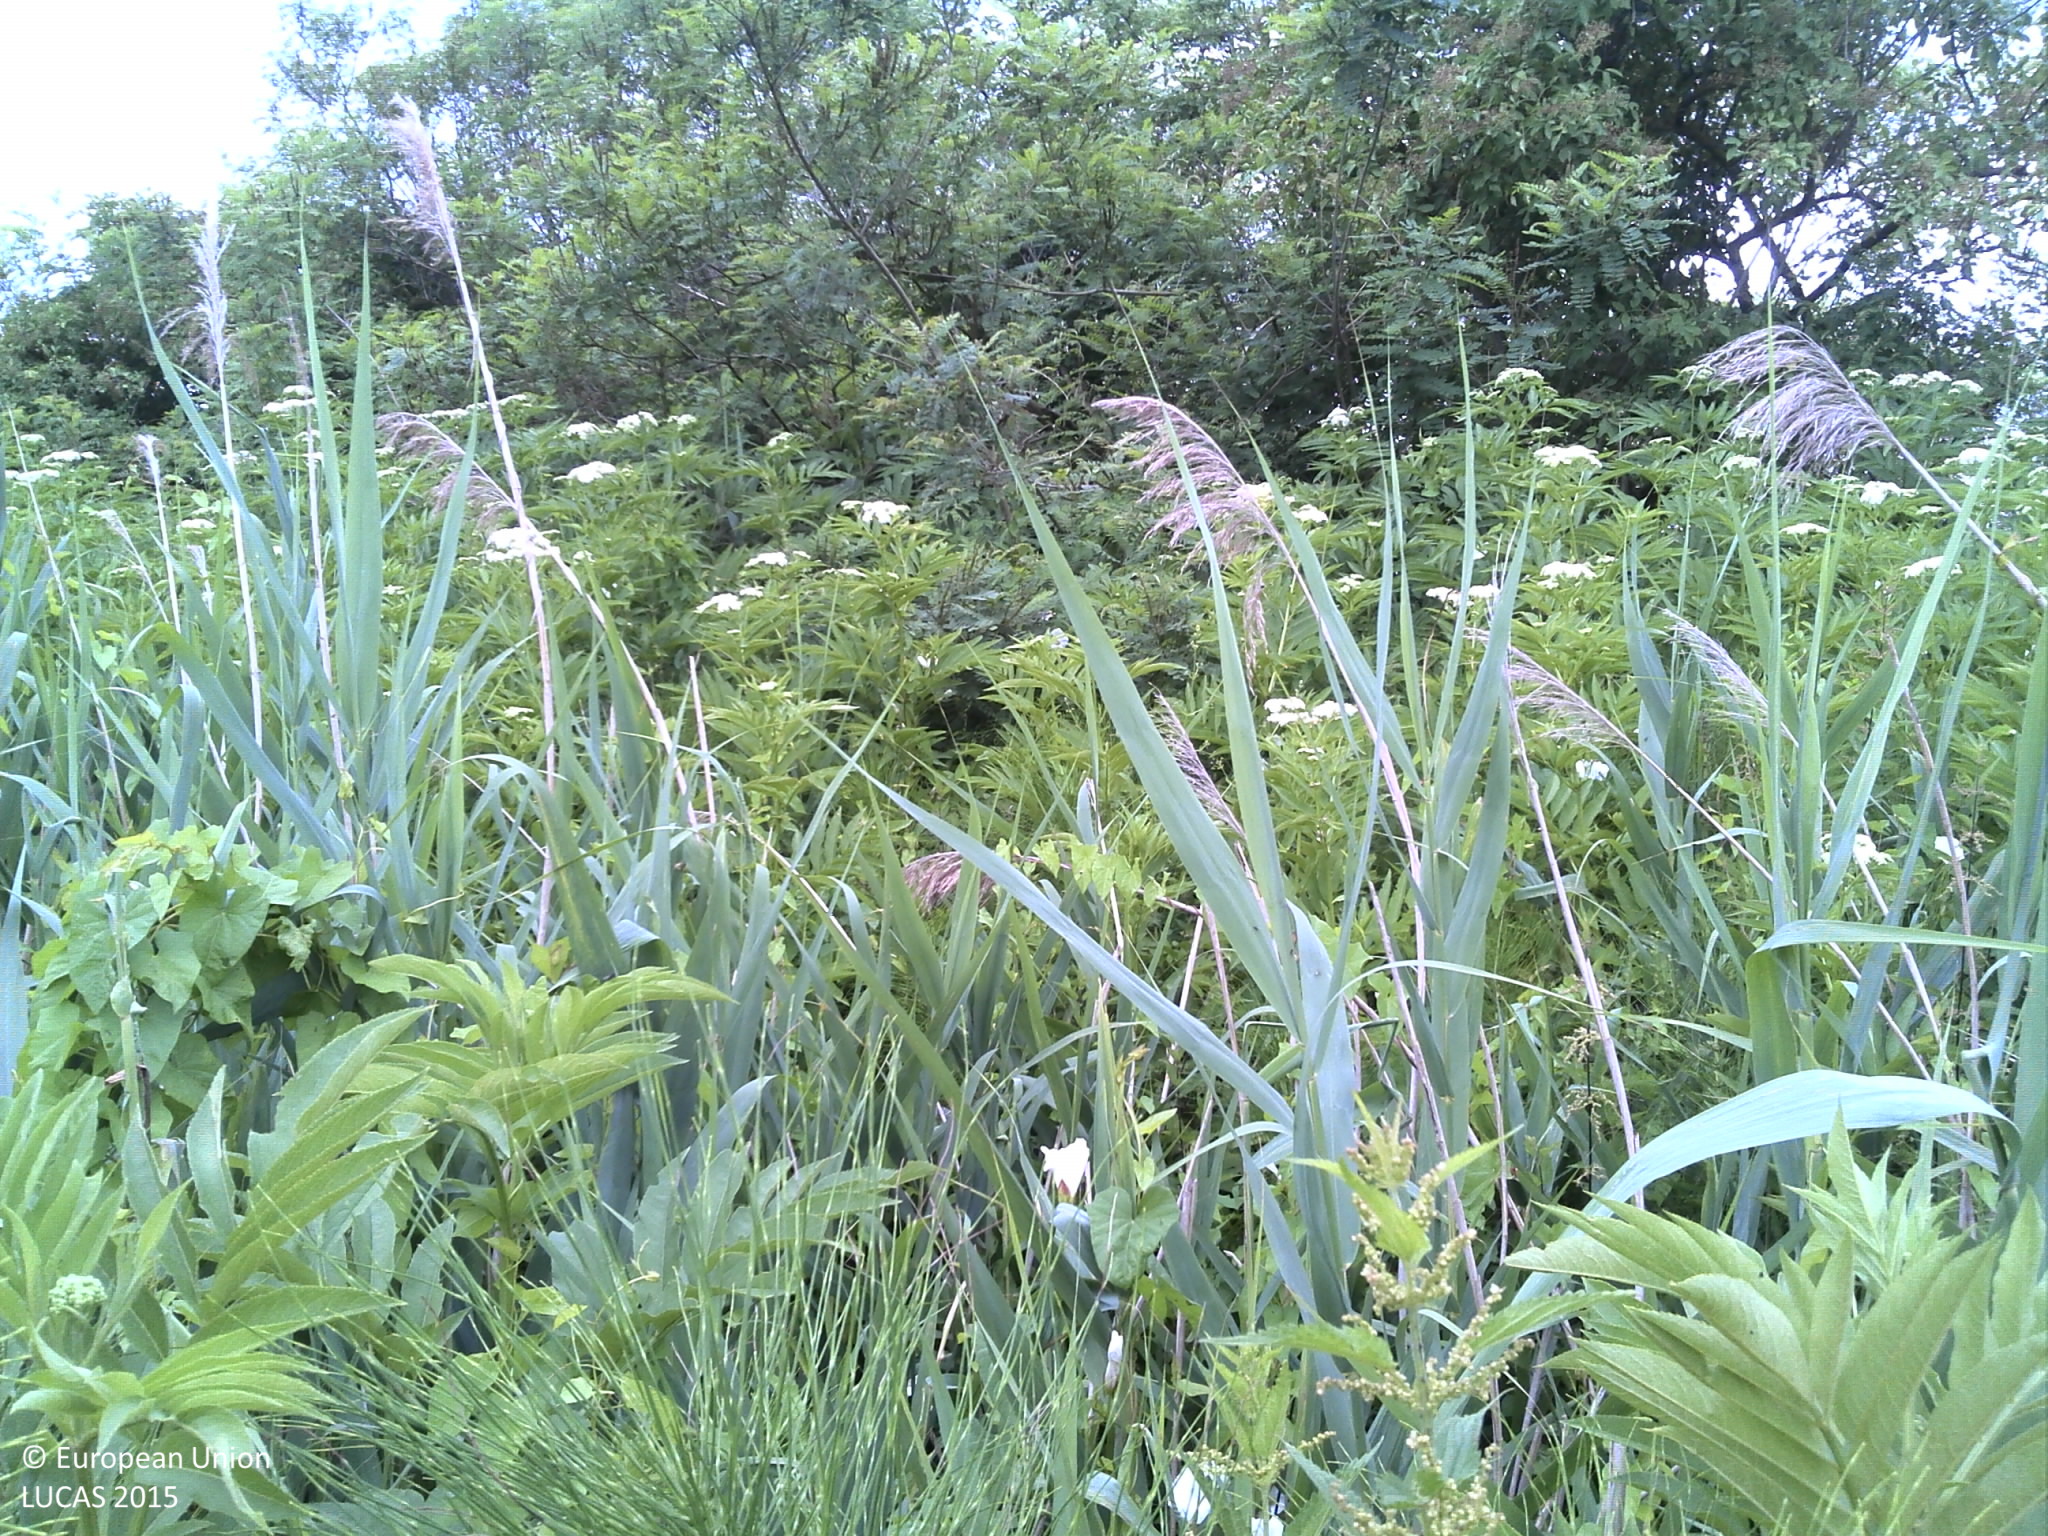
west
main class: Grassland
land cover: Spontaneously vegetated surfaces
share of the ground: > 75 %
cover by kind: herbaceous plants 90 %, shrubs 5 %, lichens and mosses 5 %
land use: Agriculture (excluding fallow land and kitchen gardens)
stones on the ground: < 10 %
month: June
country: HR
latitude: 45.2156
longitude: 17.5517
